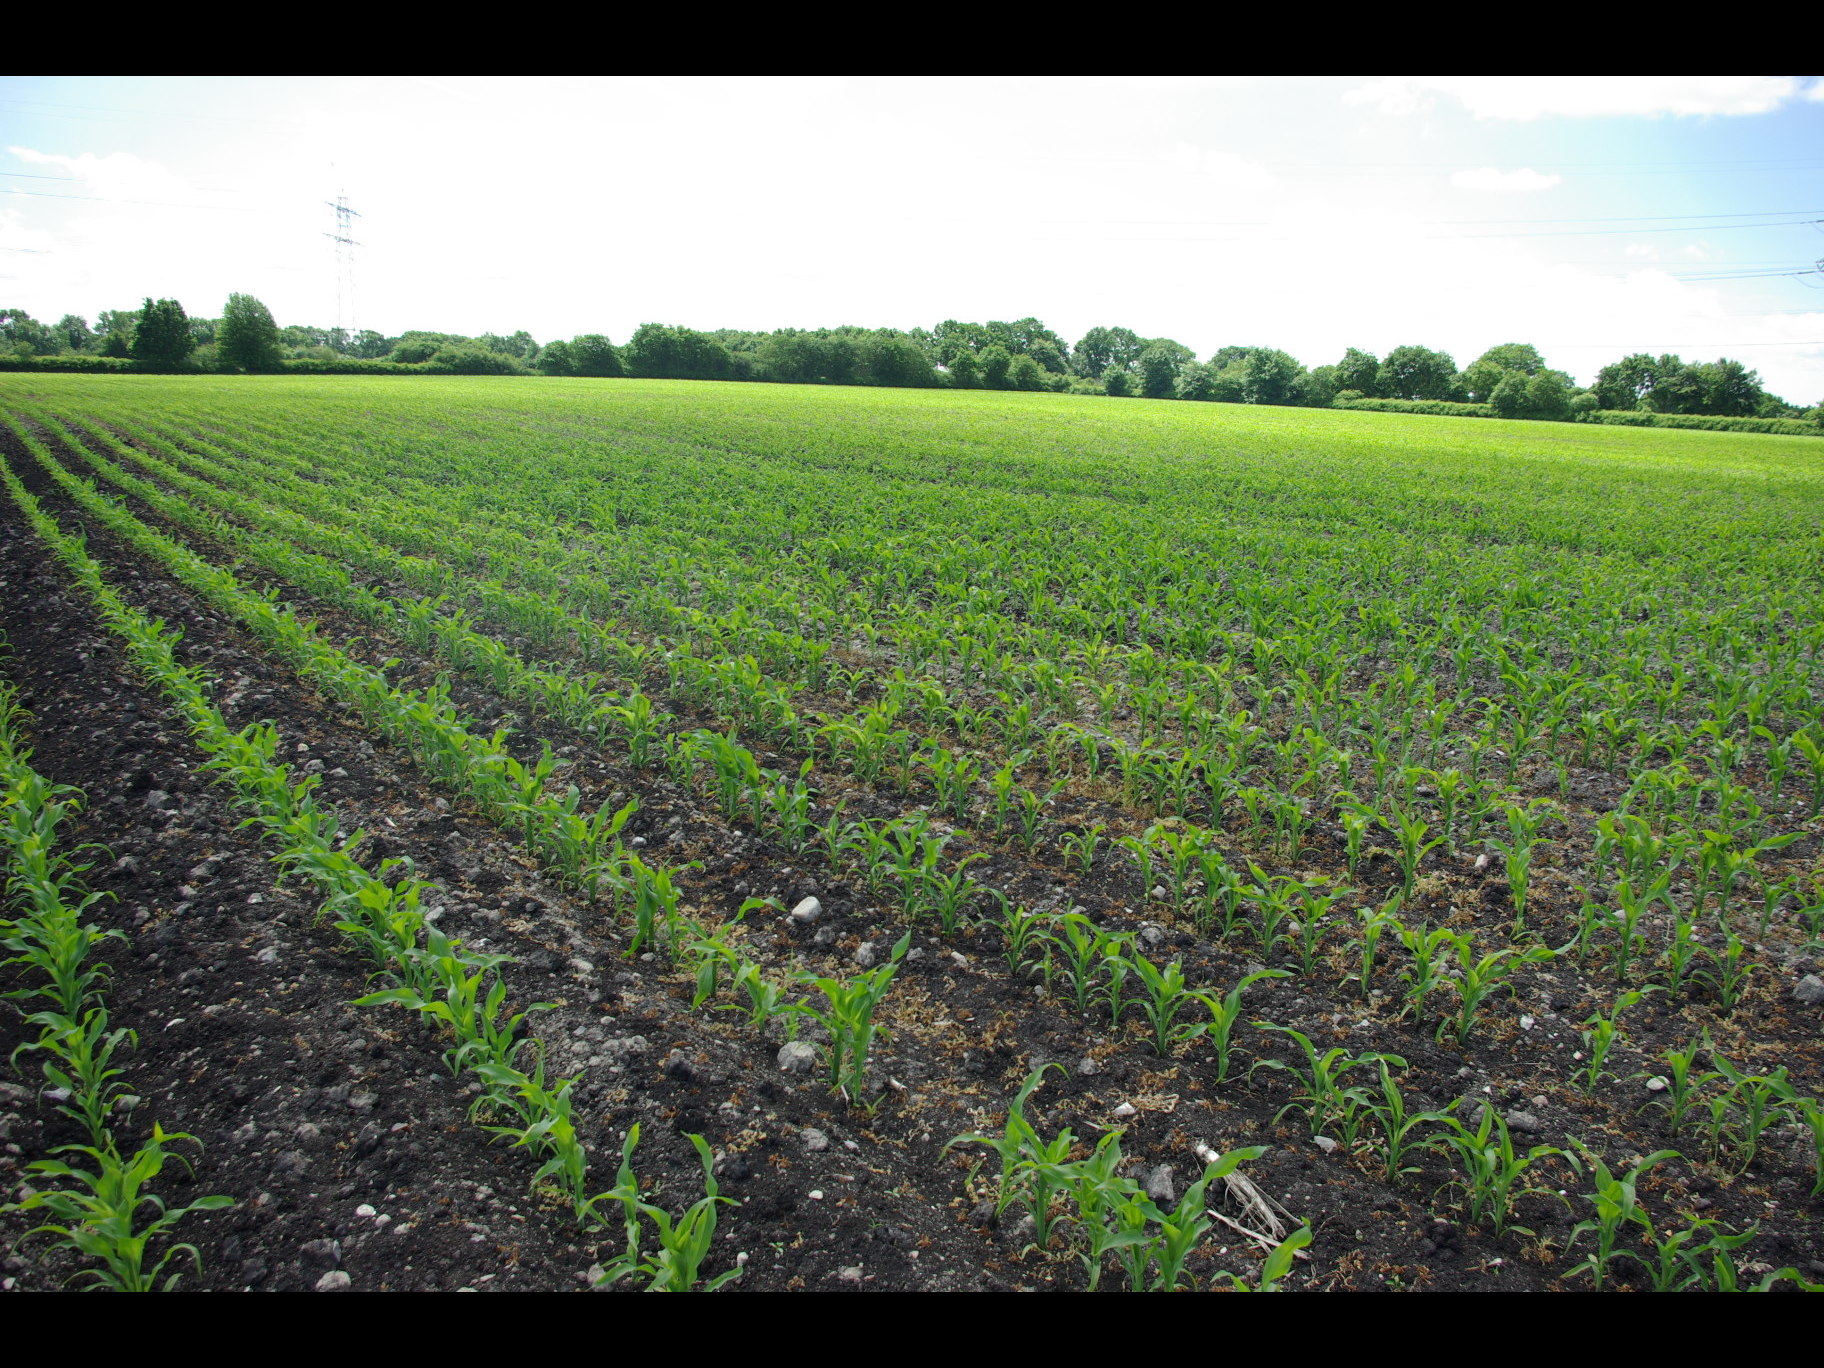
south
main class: Cropland
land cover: Maize
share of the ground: 25 - 50 %
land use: Agriculture (excluding fallow land and kitchen gardens)
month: June
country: DE
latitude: 54.3539
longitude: 9.6463
